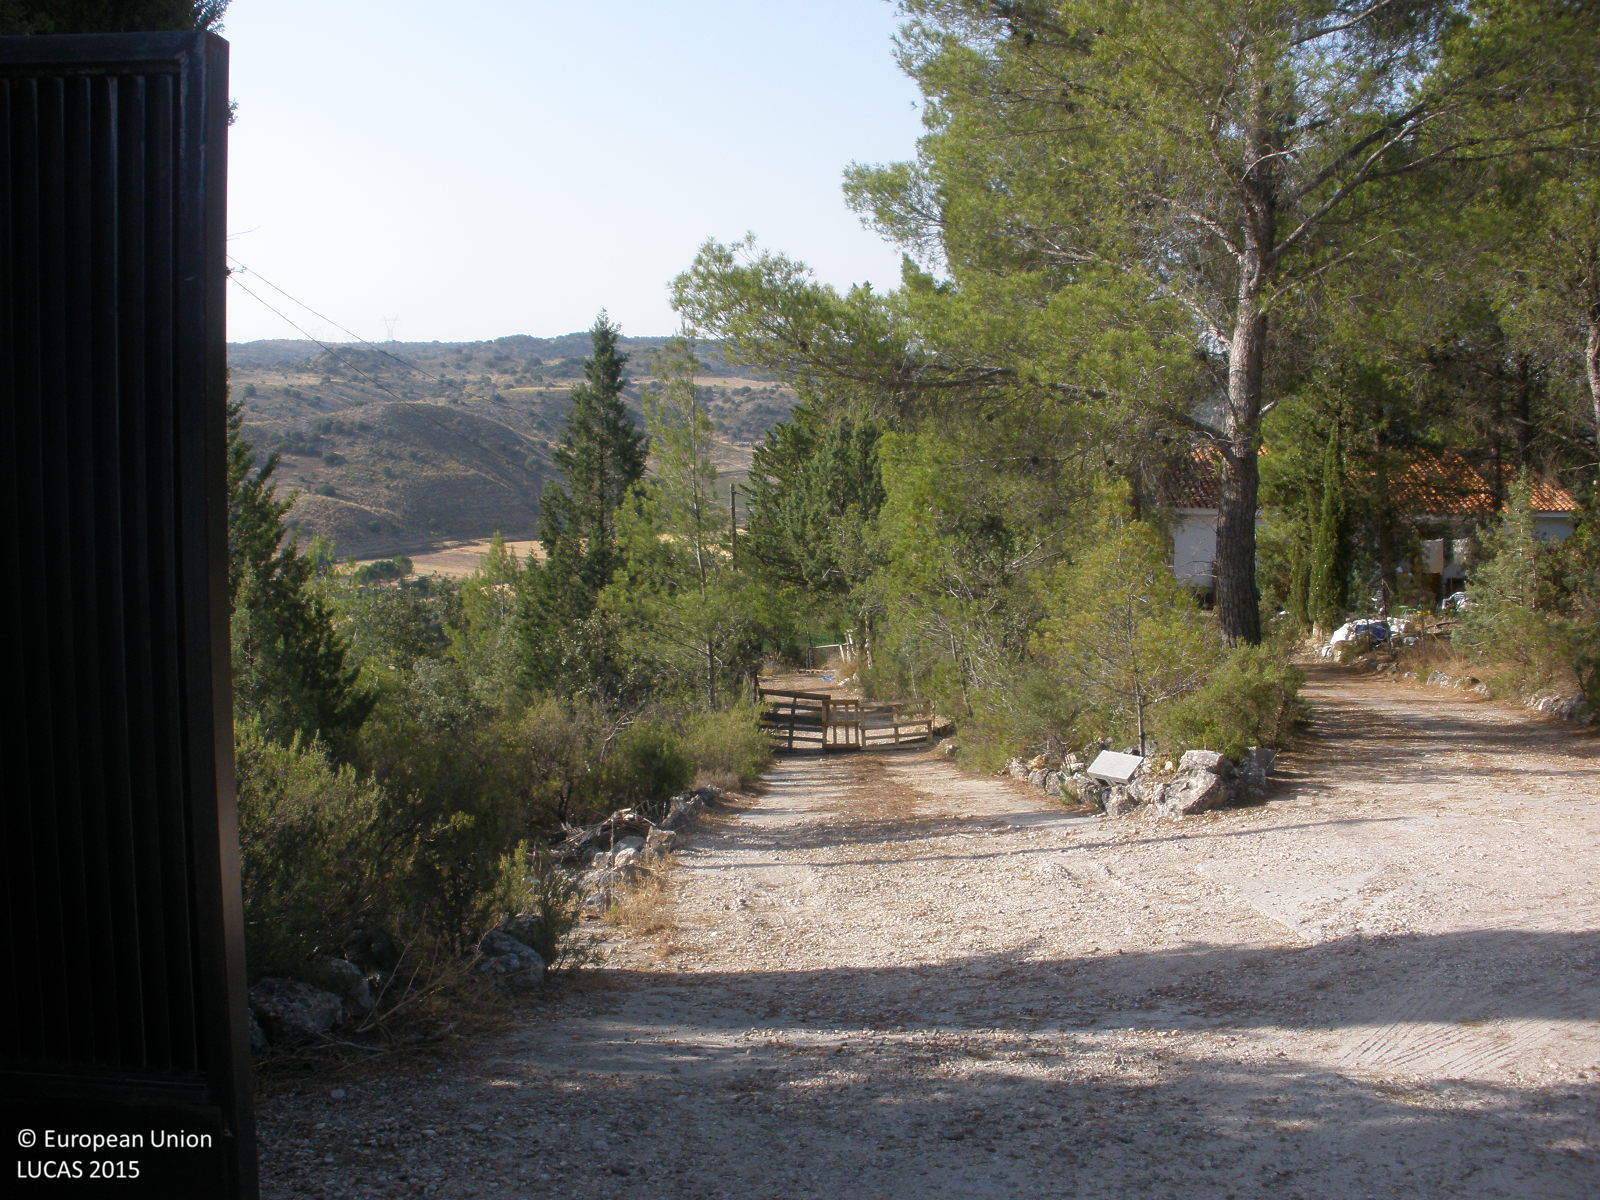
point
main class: Woodland
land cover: Pine dominated coniferous woodland
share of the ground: 50 - 75 %
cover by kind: coniferous forest trees 50 %, shrubs 40 %, consolidated bare surface 10 %
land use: Residential
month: July
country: ES
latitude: 40.2120
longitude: -3.3427
